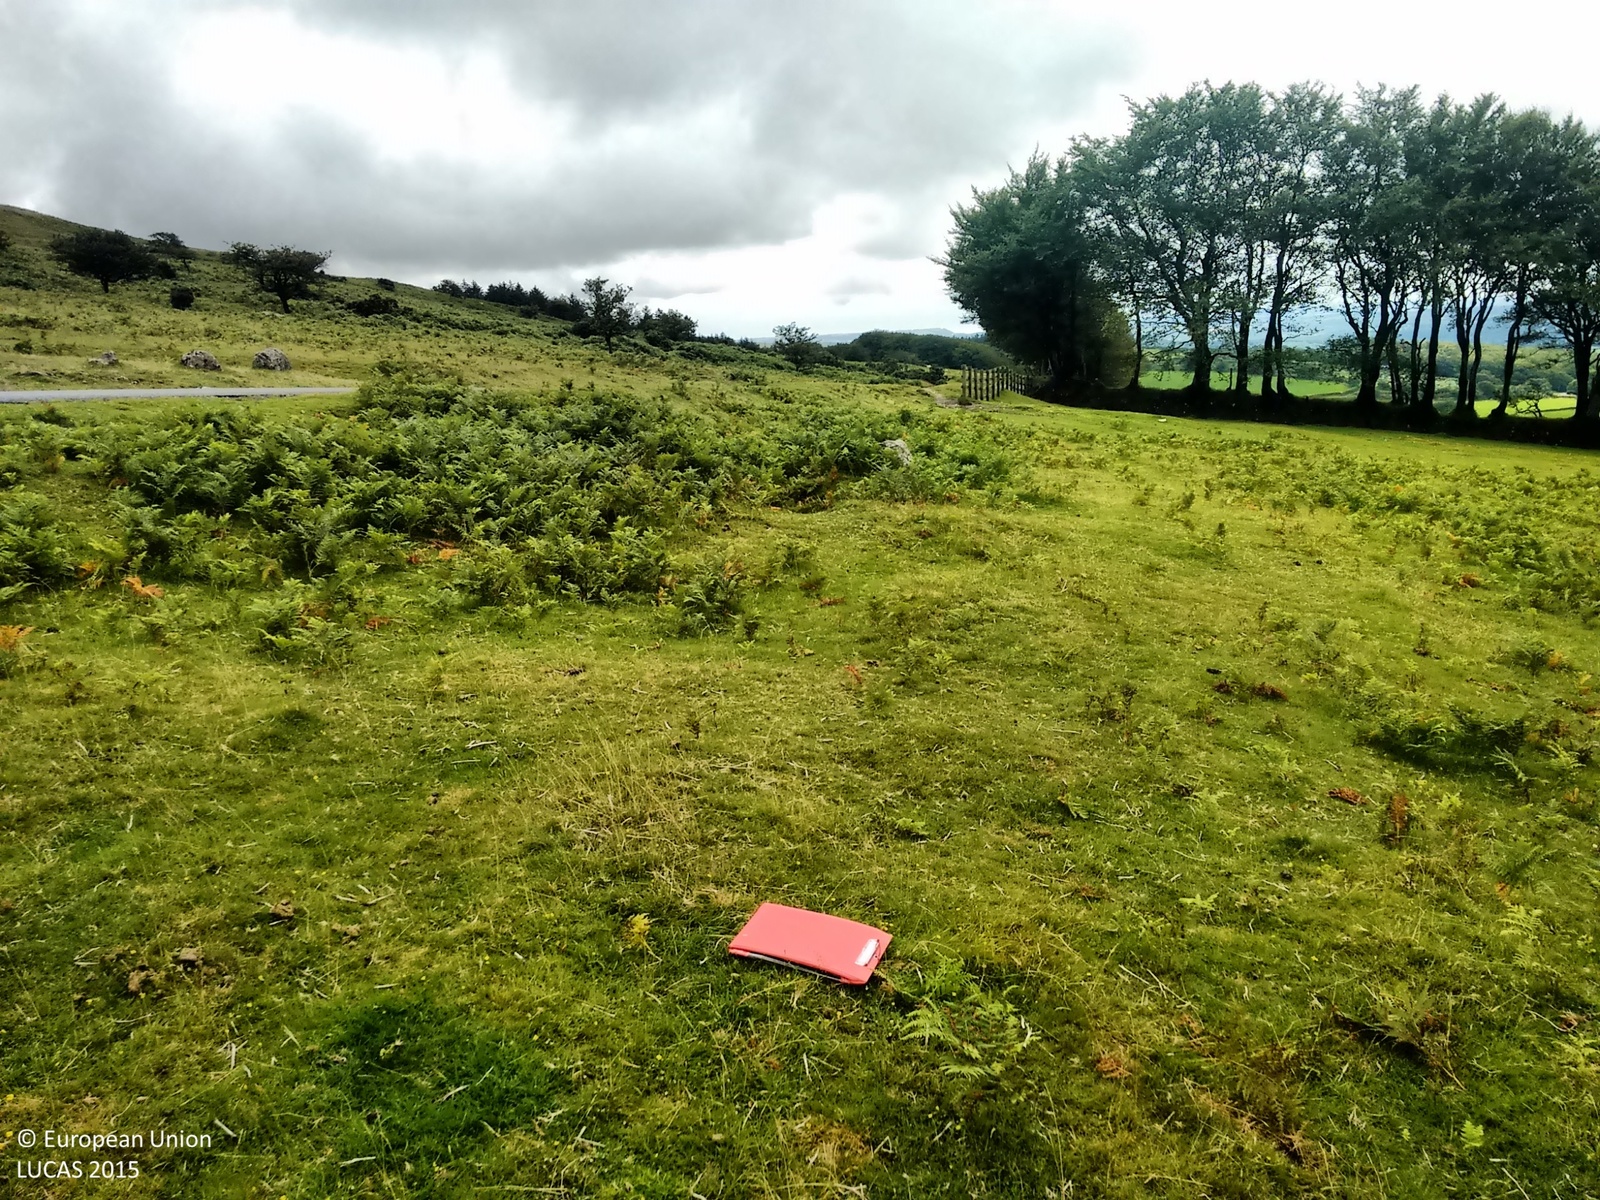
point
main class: Grassland
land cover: Grassland without tree/shrub cover
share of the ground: > 75 %
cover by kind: herbaceous plants 100 %
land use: Agriculture (excluding fallow land and kitchen gardens)
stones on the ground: < 10 %
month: August
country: GB
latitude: 50.5146
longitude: -4.0421
